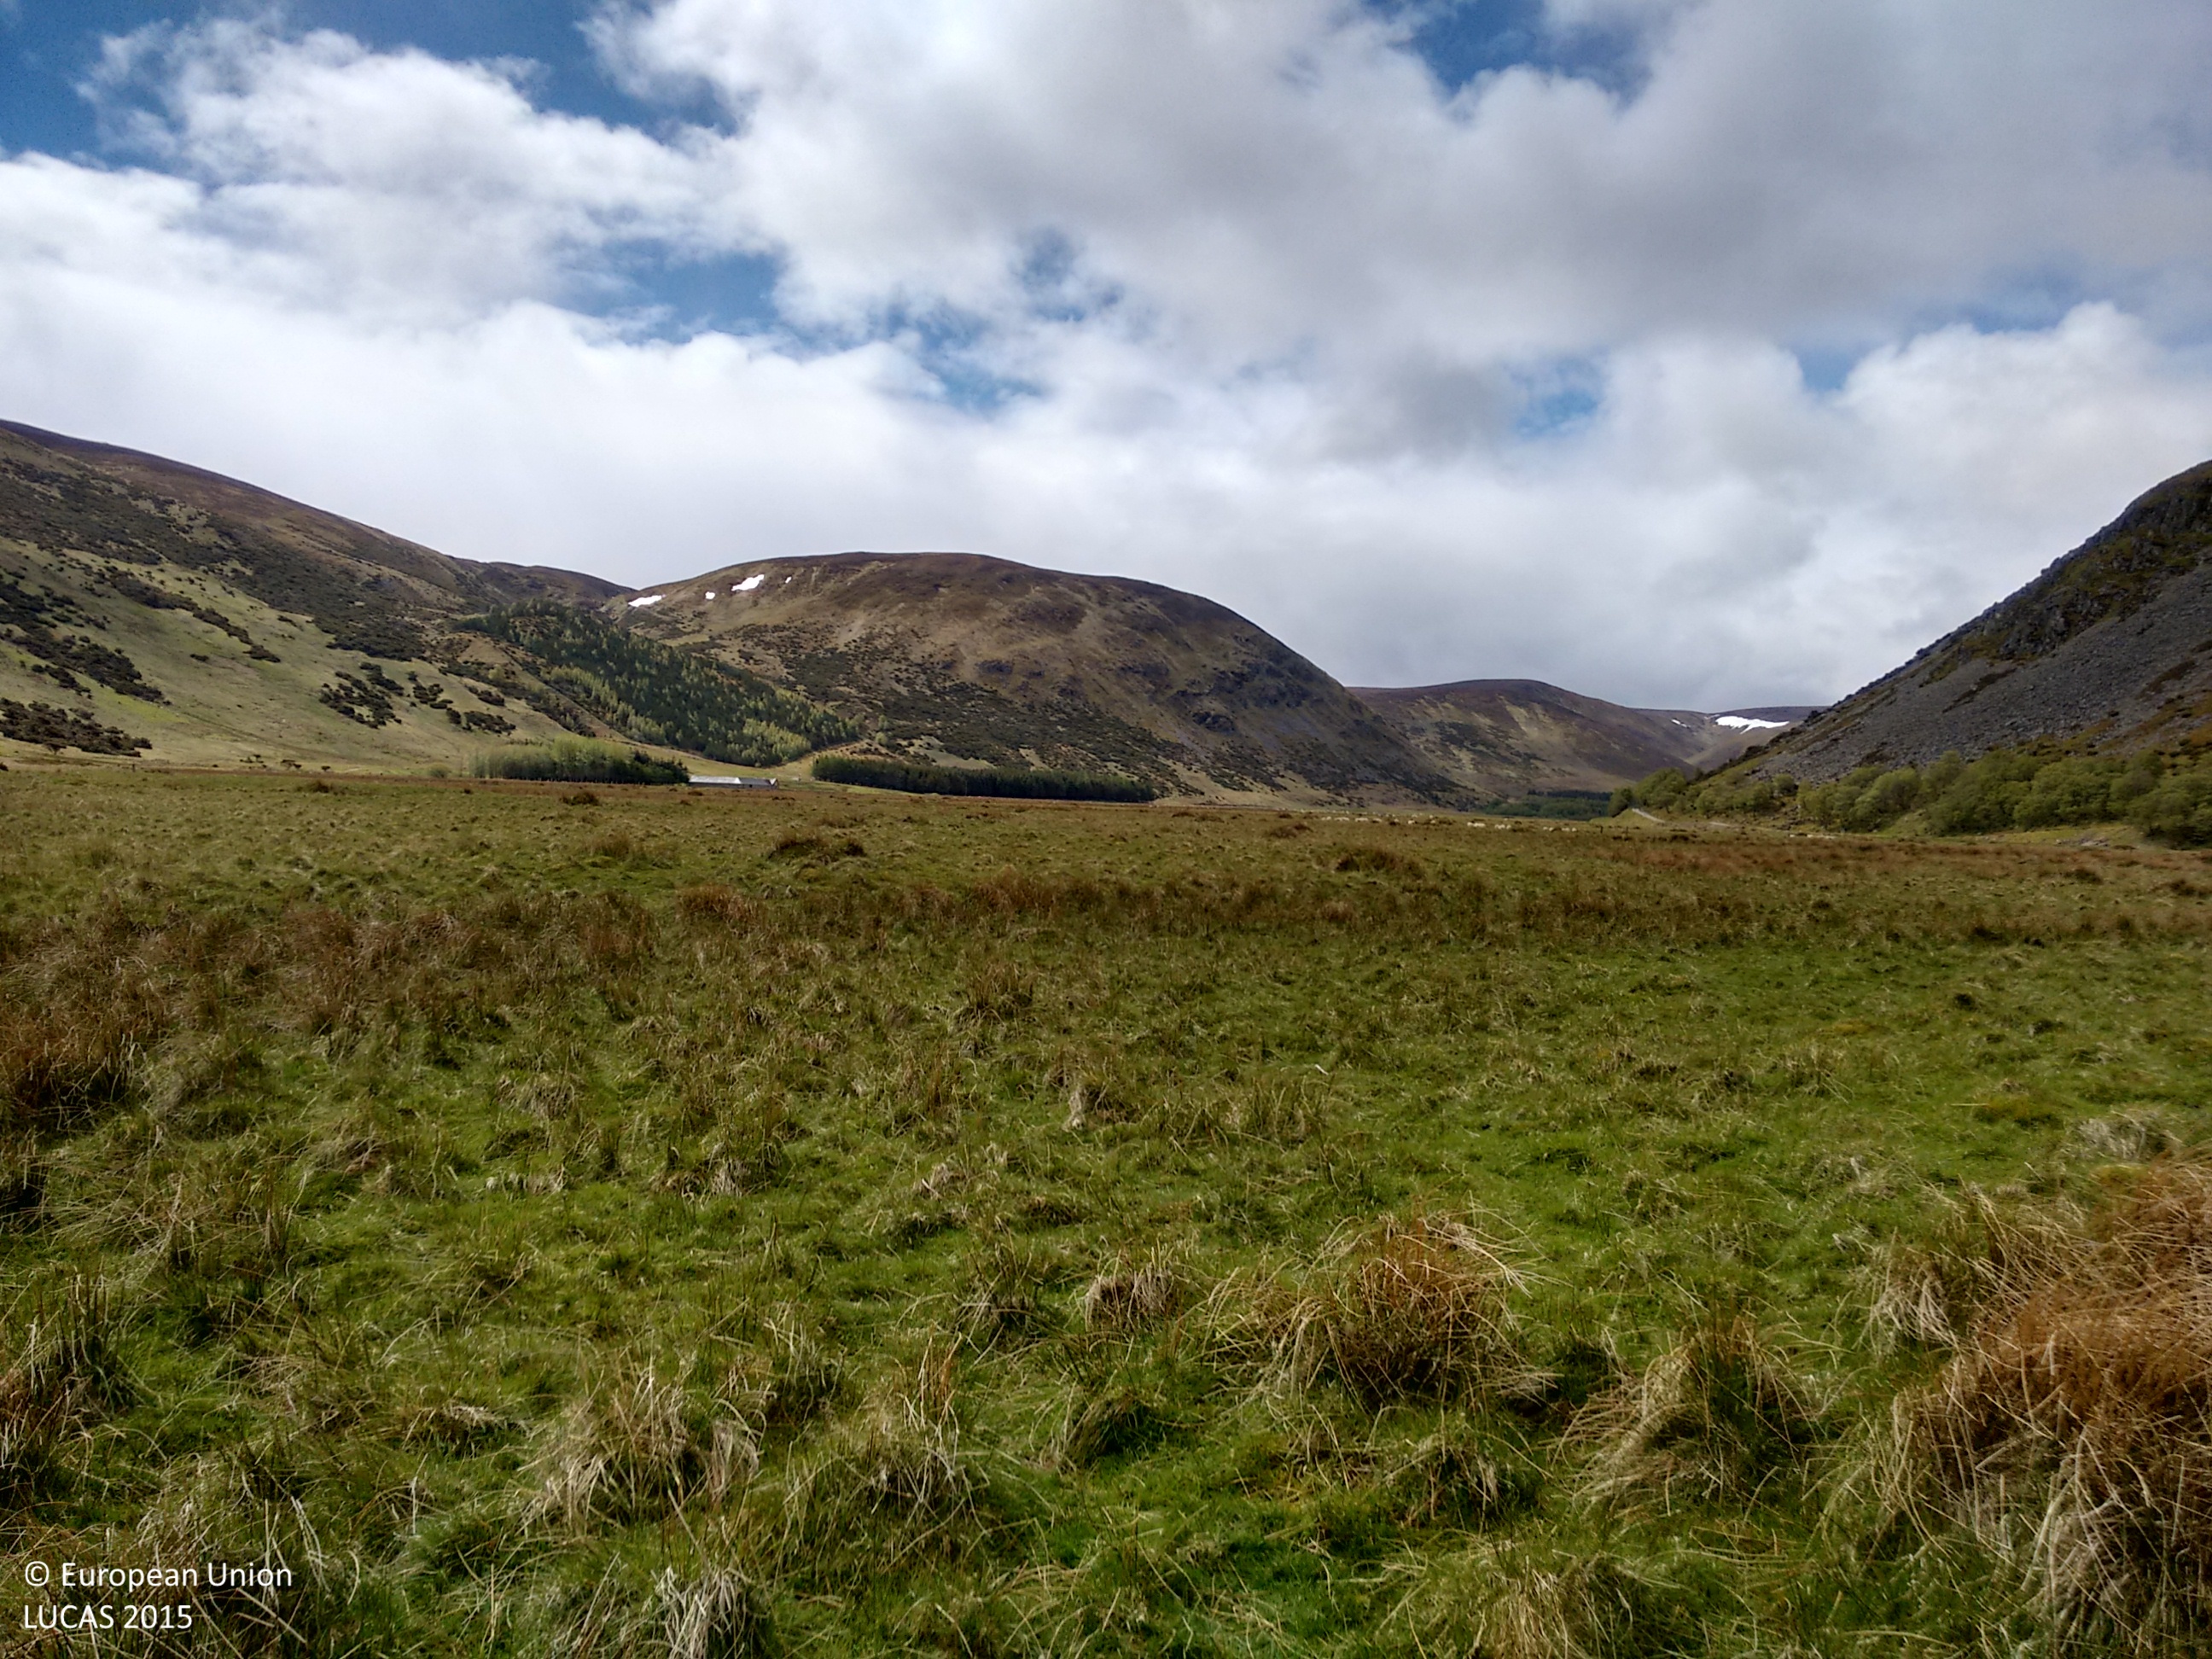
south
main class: Grassland
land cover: Grassland without tree/shrub cover
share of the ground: > 75 %
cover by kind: herbaceous plants 100 %
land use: Agriculture (excluding fallow land and kitchen gardens)
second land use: Other primary production
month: June
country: GB
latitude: 57.2524
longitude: -4.0894
